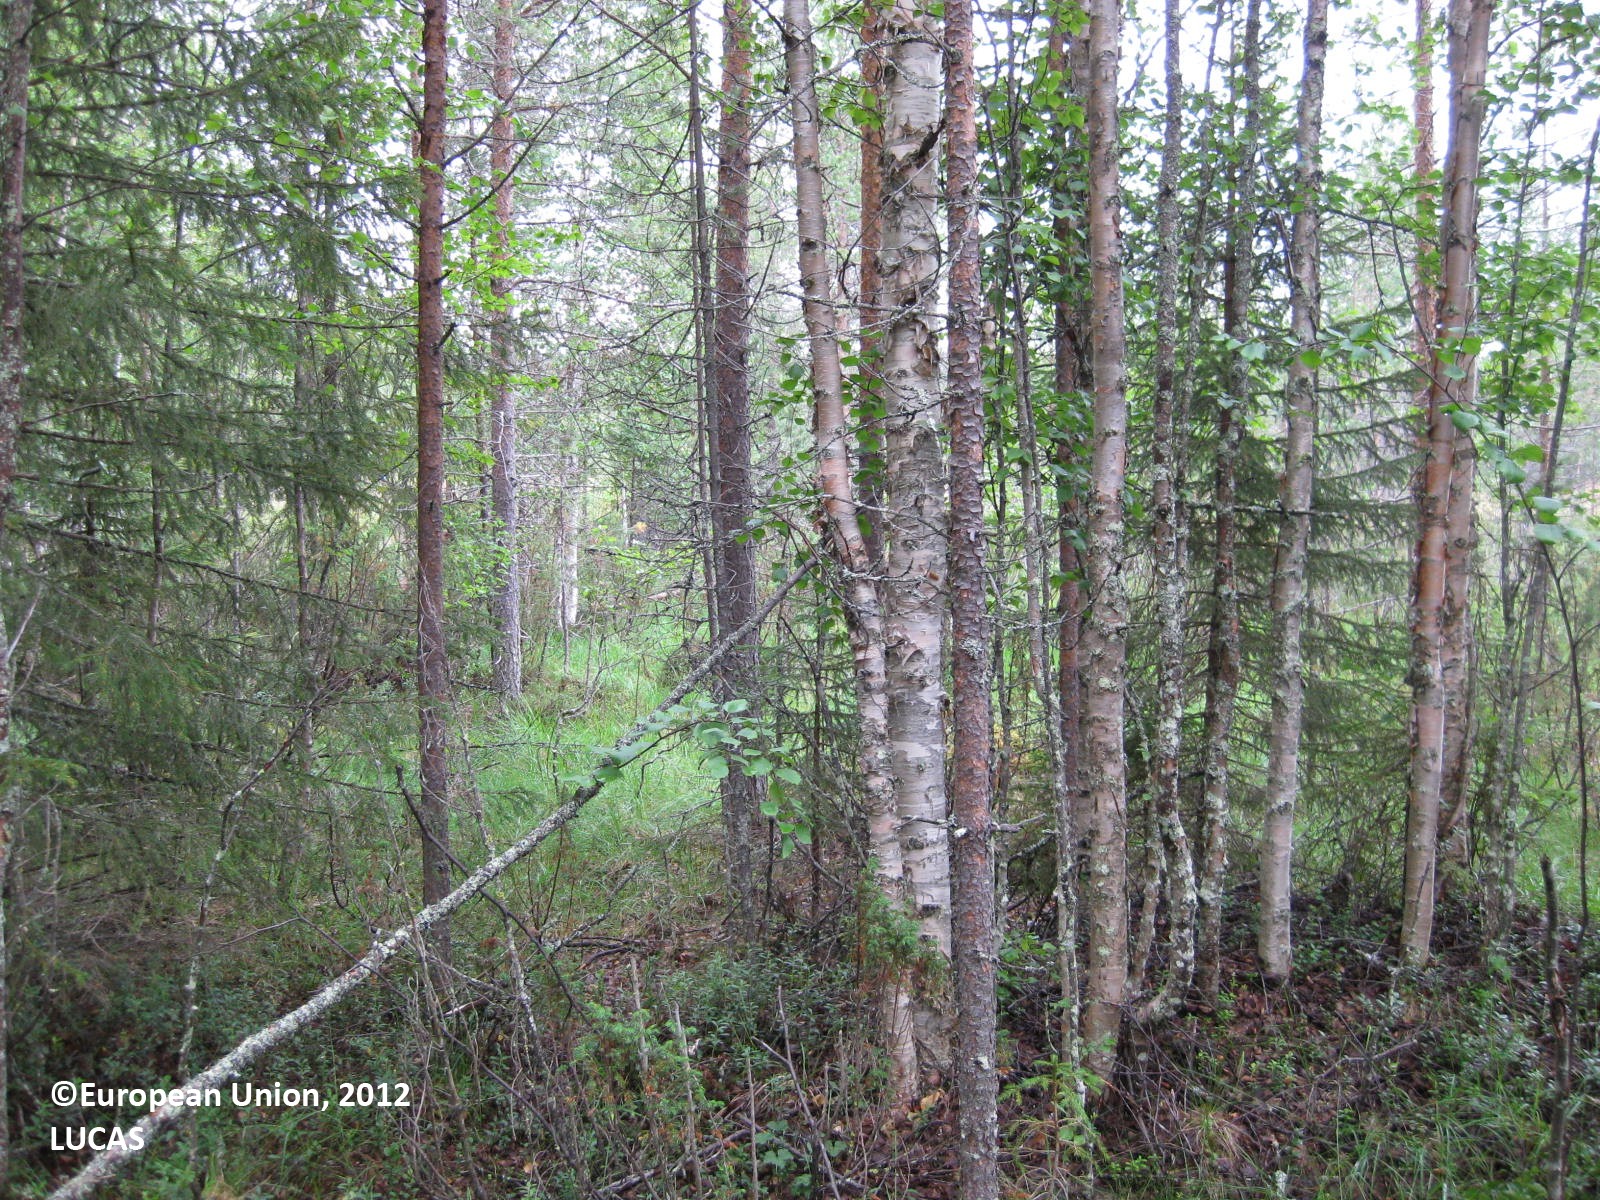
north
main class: Woodland
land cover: Pine dominated mixed woodland
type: boreal forest
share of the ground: > 75 %
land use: Forestry
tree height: > 5 m
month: August
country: FI
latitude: 66.0846
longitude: 28.2951
